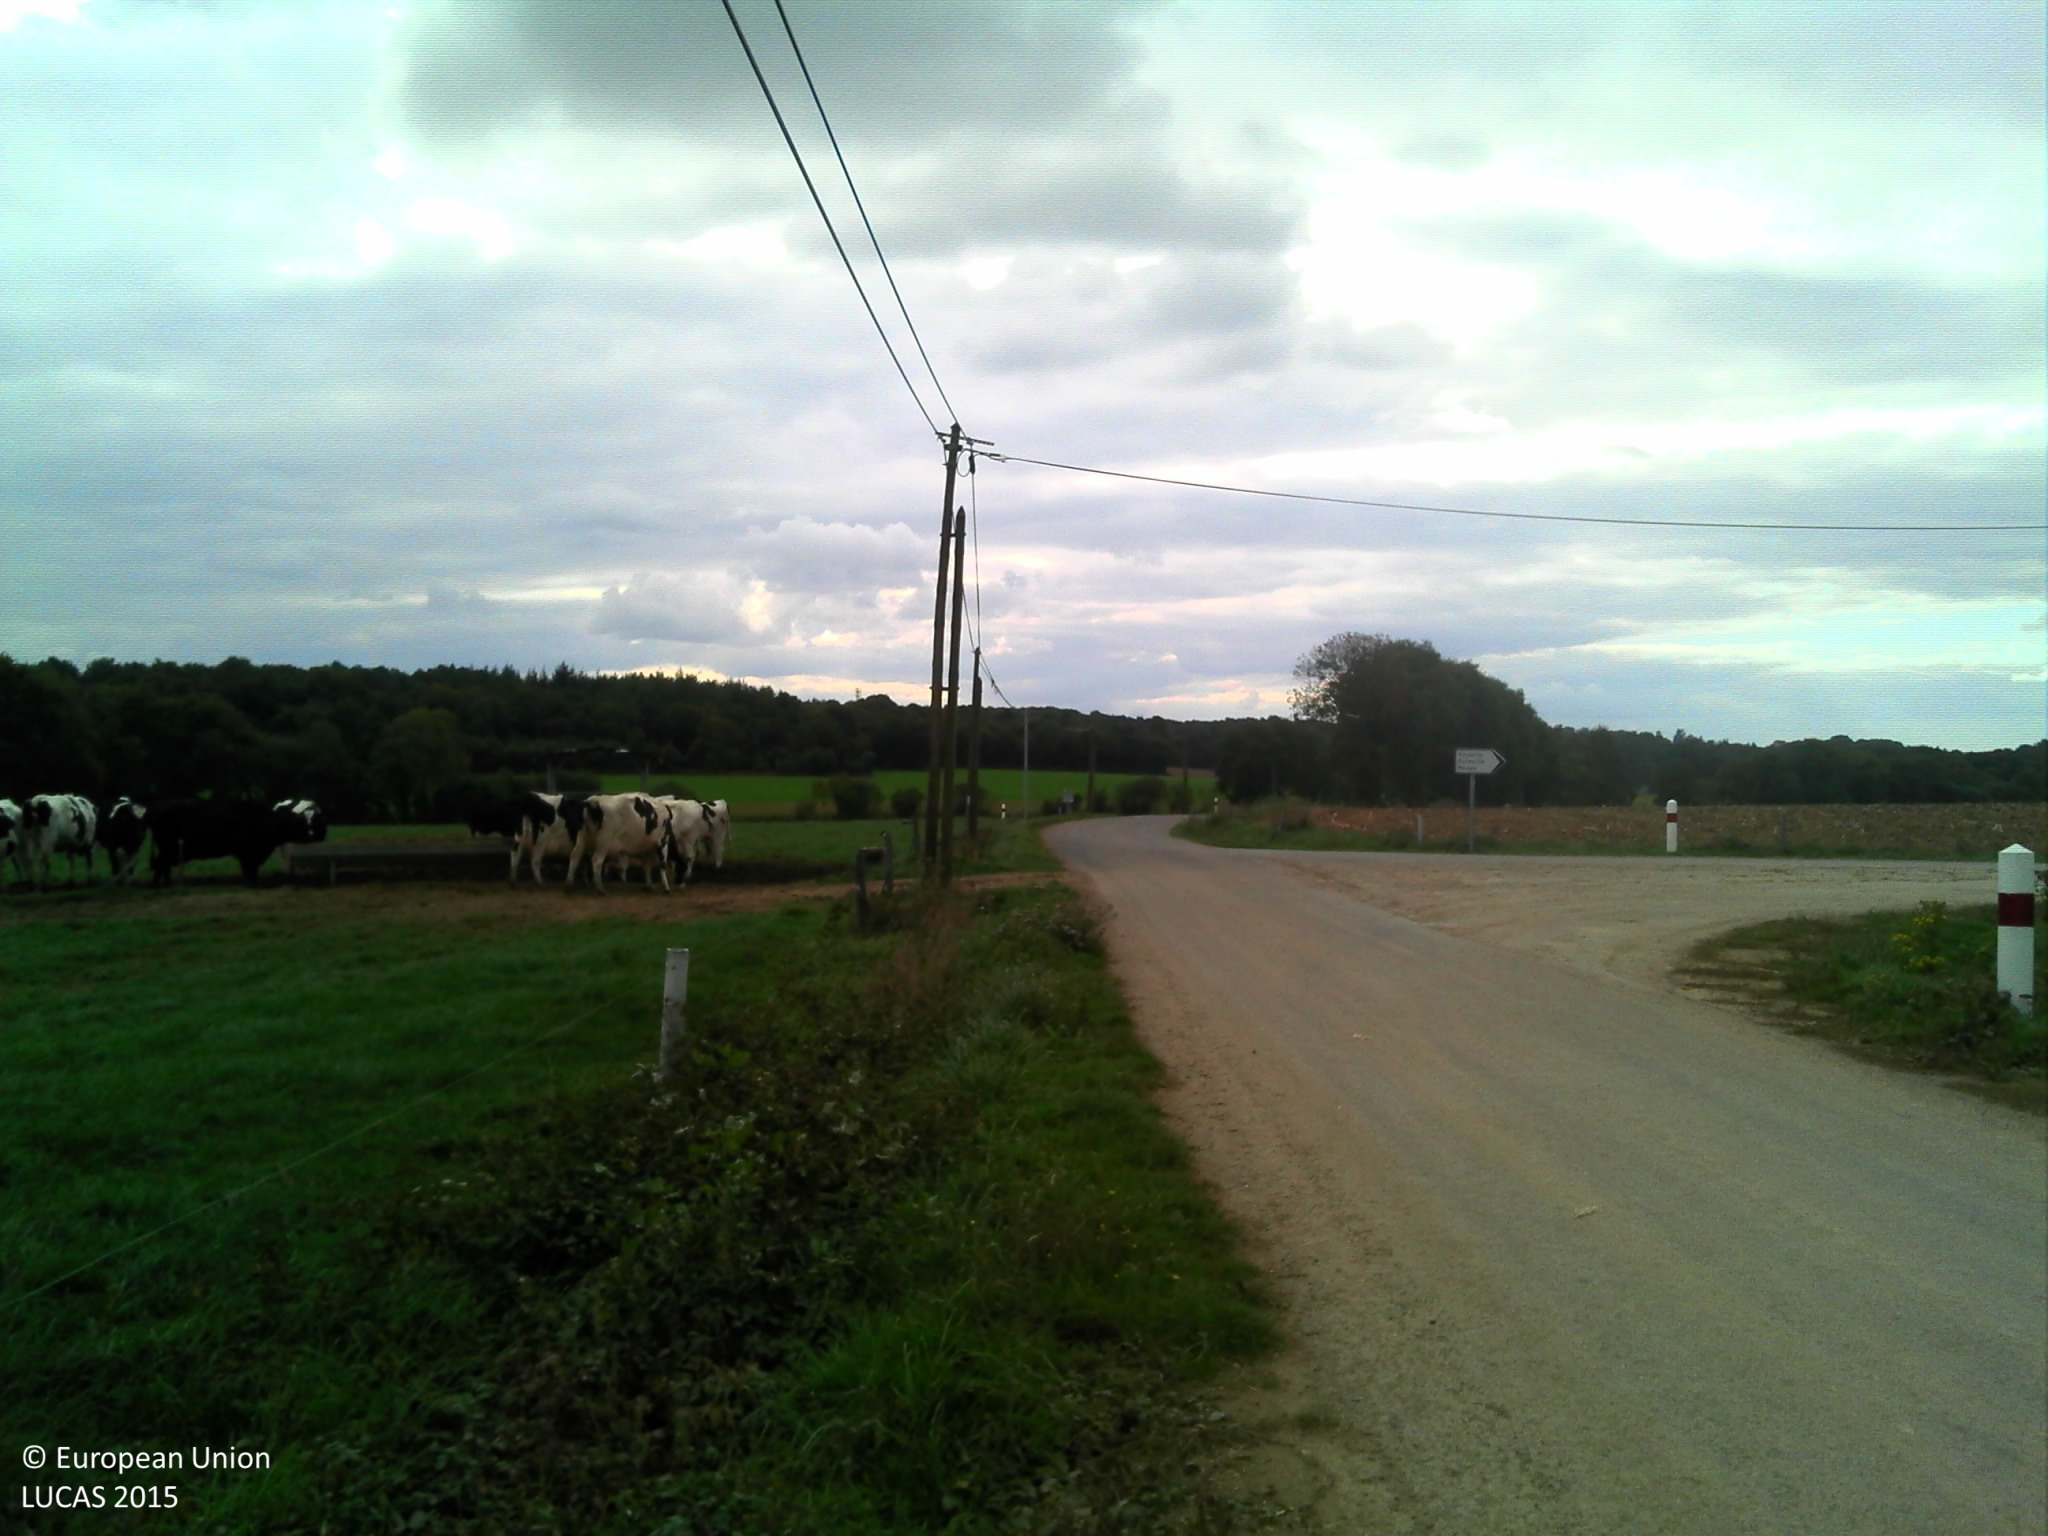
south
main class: Grassland
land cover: Grassland without tree/shrub cover
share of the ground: > 75 %
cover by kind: herbaceous plants 100 %
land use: Agriculture (excluding fallow land and kitchen gardens)
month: October
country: FR
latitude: 48.1028
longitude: -2.3999
